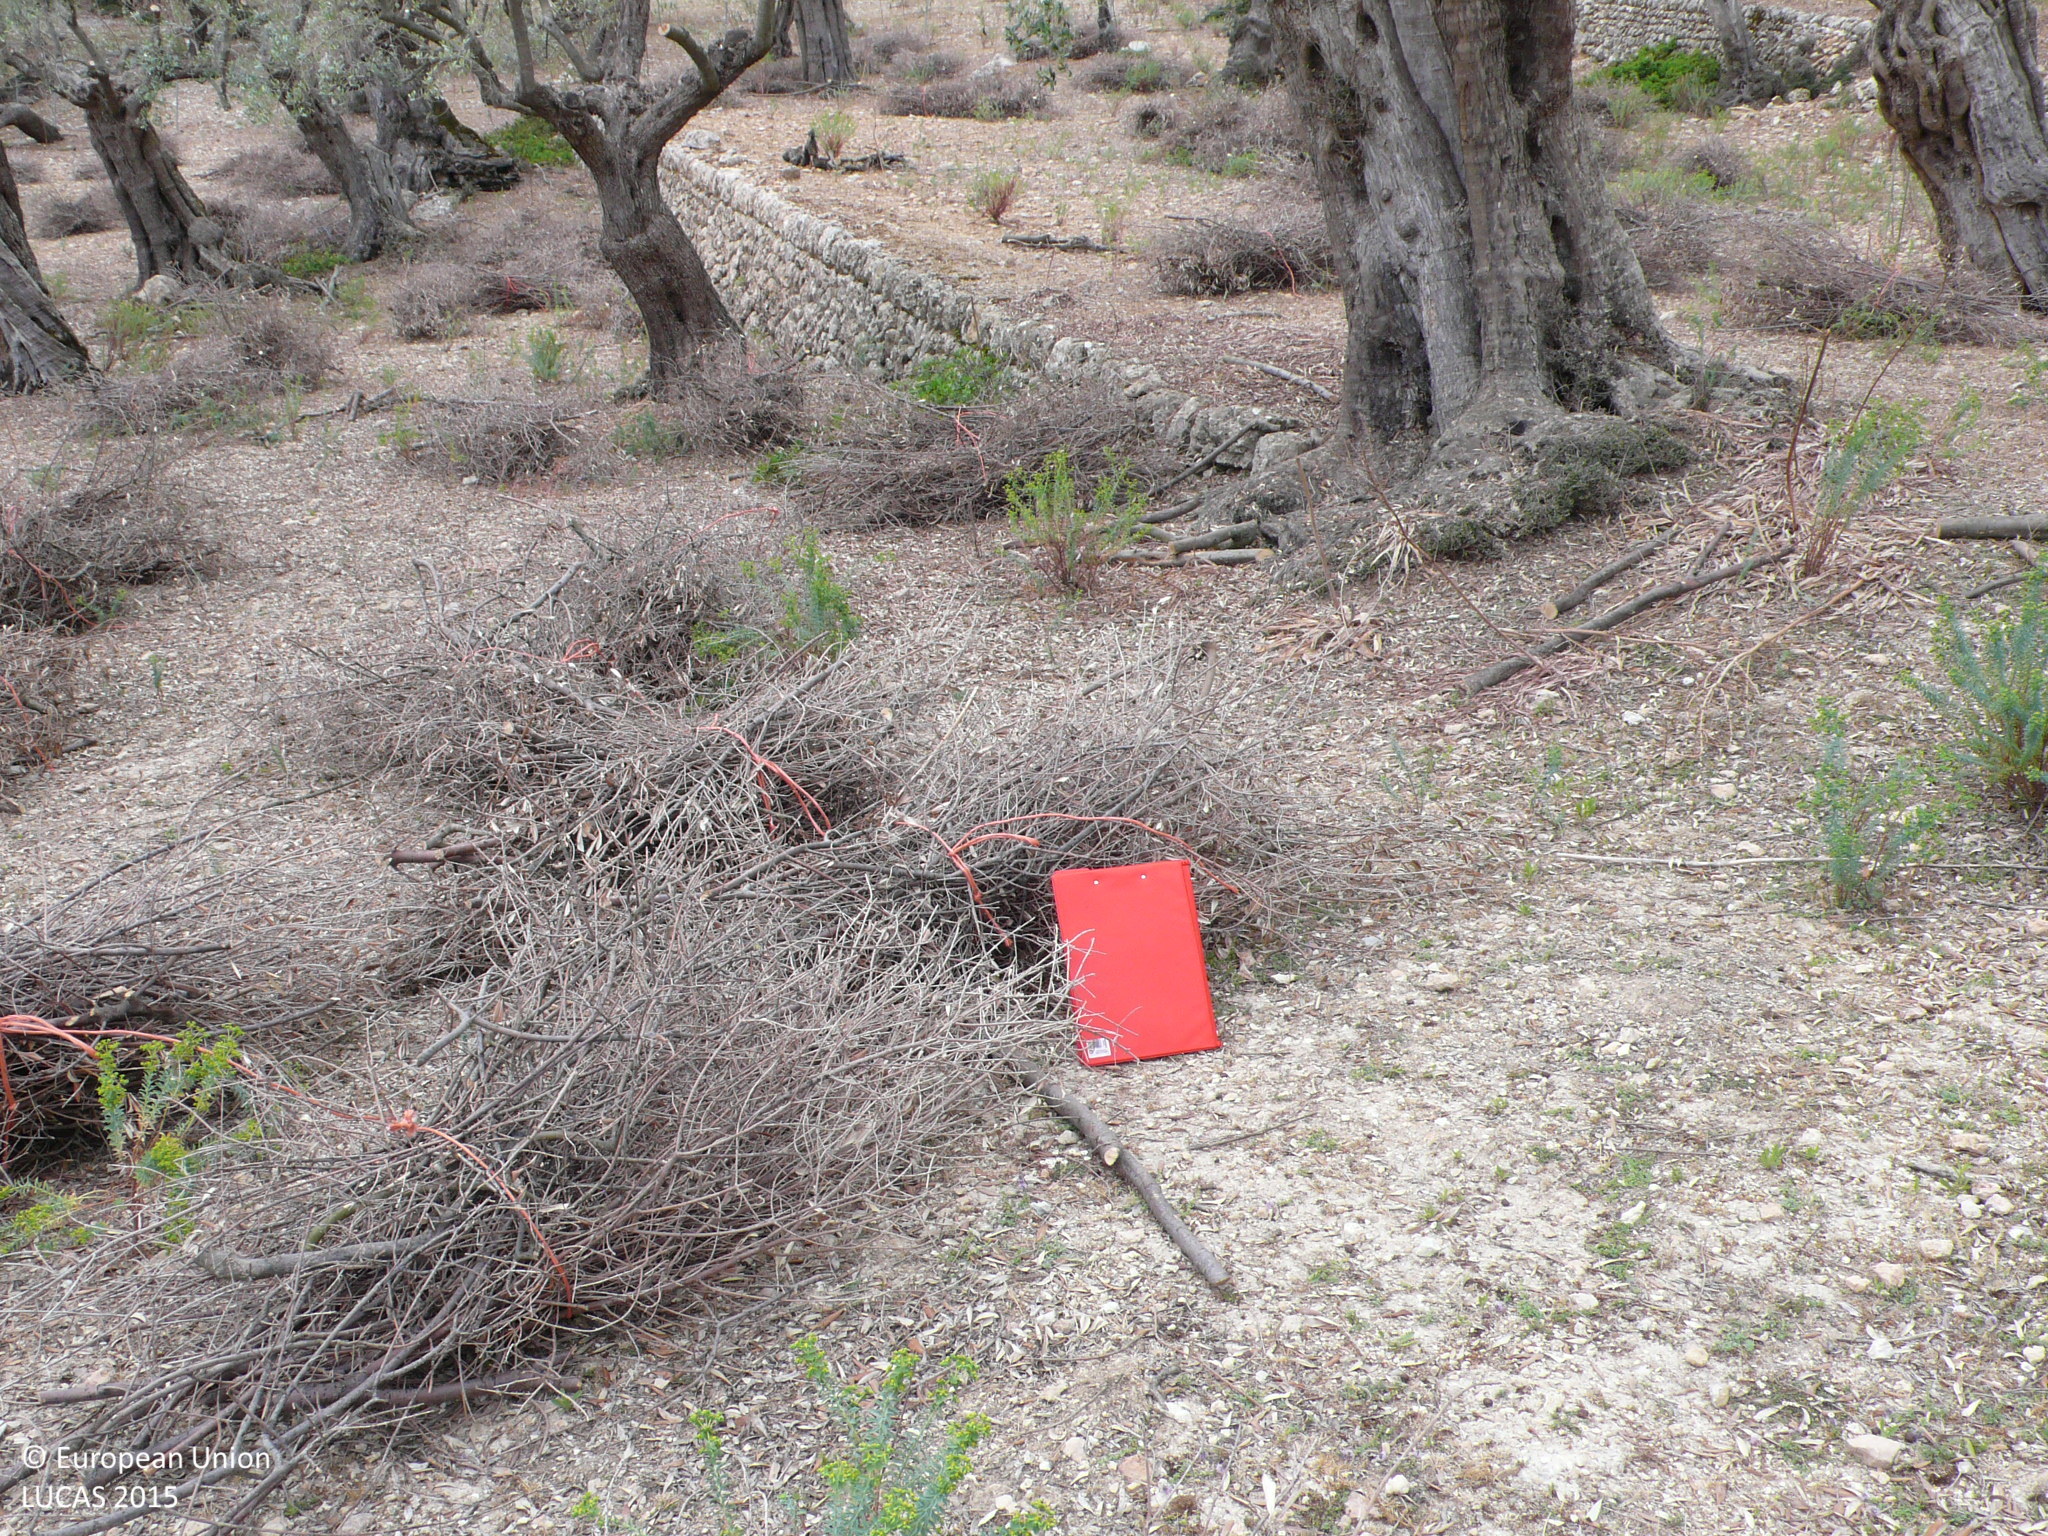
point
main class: Cropland
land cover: Olive groves
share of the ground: 25 - 50 %
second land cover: Spontaneously vegetated surfaces
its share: 10 - 25 %
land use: Agriculture (excluding fallow land and kitchen gardens)
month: June
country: ES
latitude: 39.7288
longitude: 2.7840
